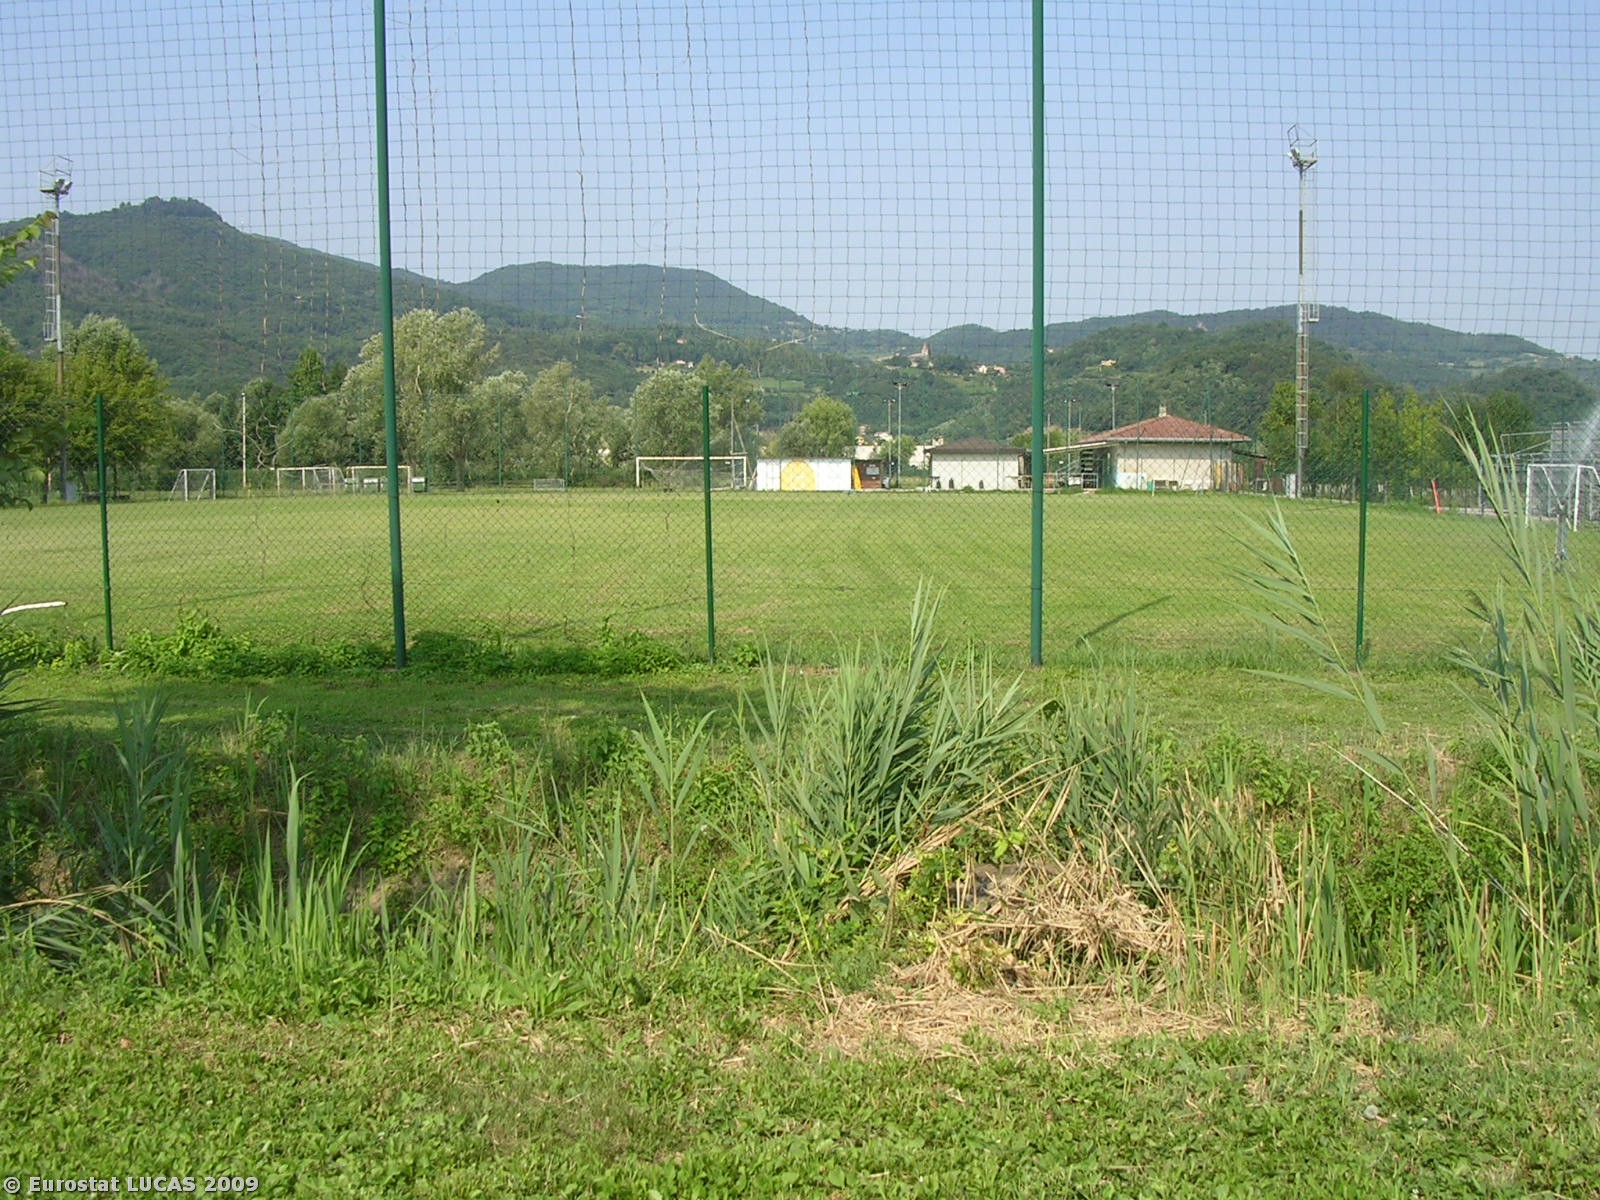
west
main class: Grassland
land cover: Grassland without tree/shrub cover
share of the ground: > 75 %
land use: Fallow land
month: July
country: IT
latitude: 45.3278
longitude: 11.7450
